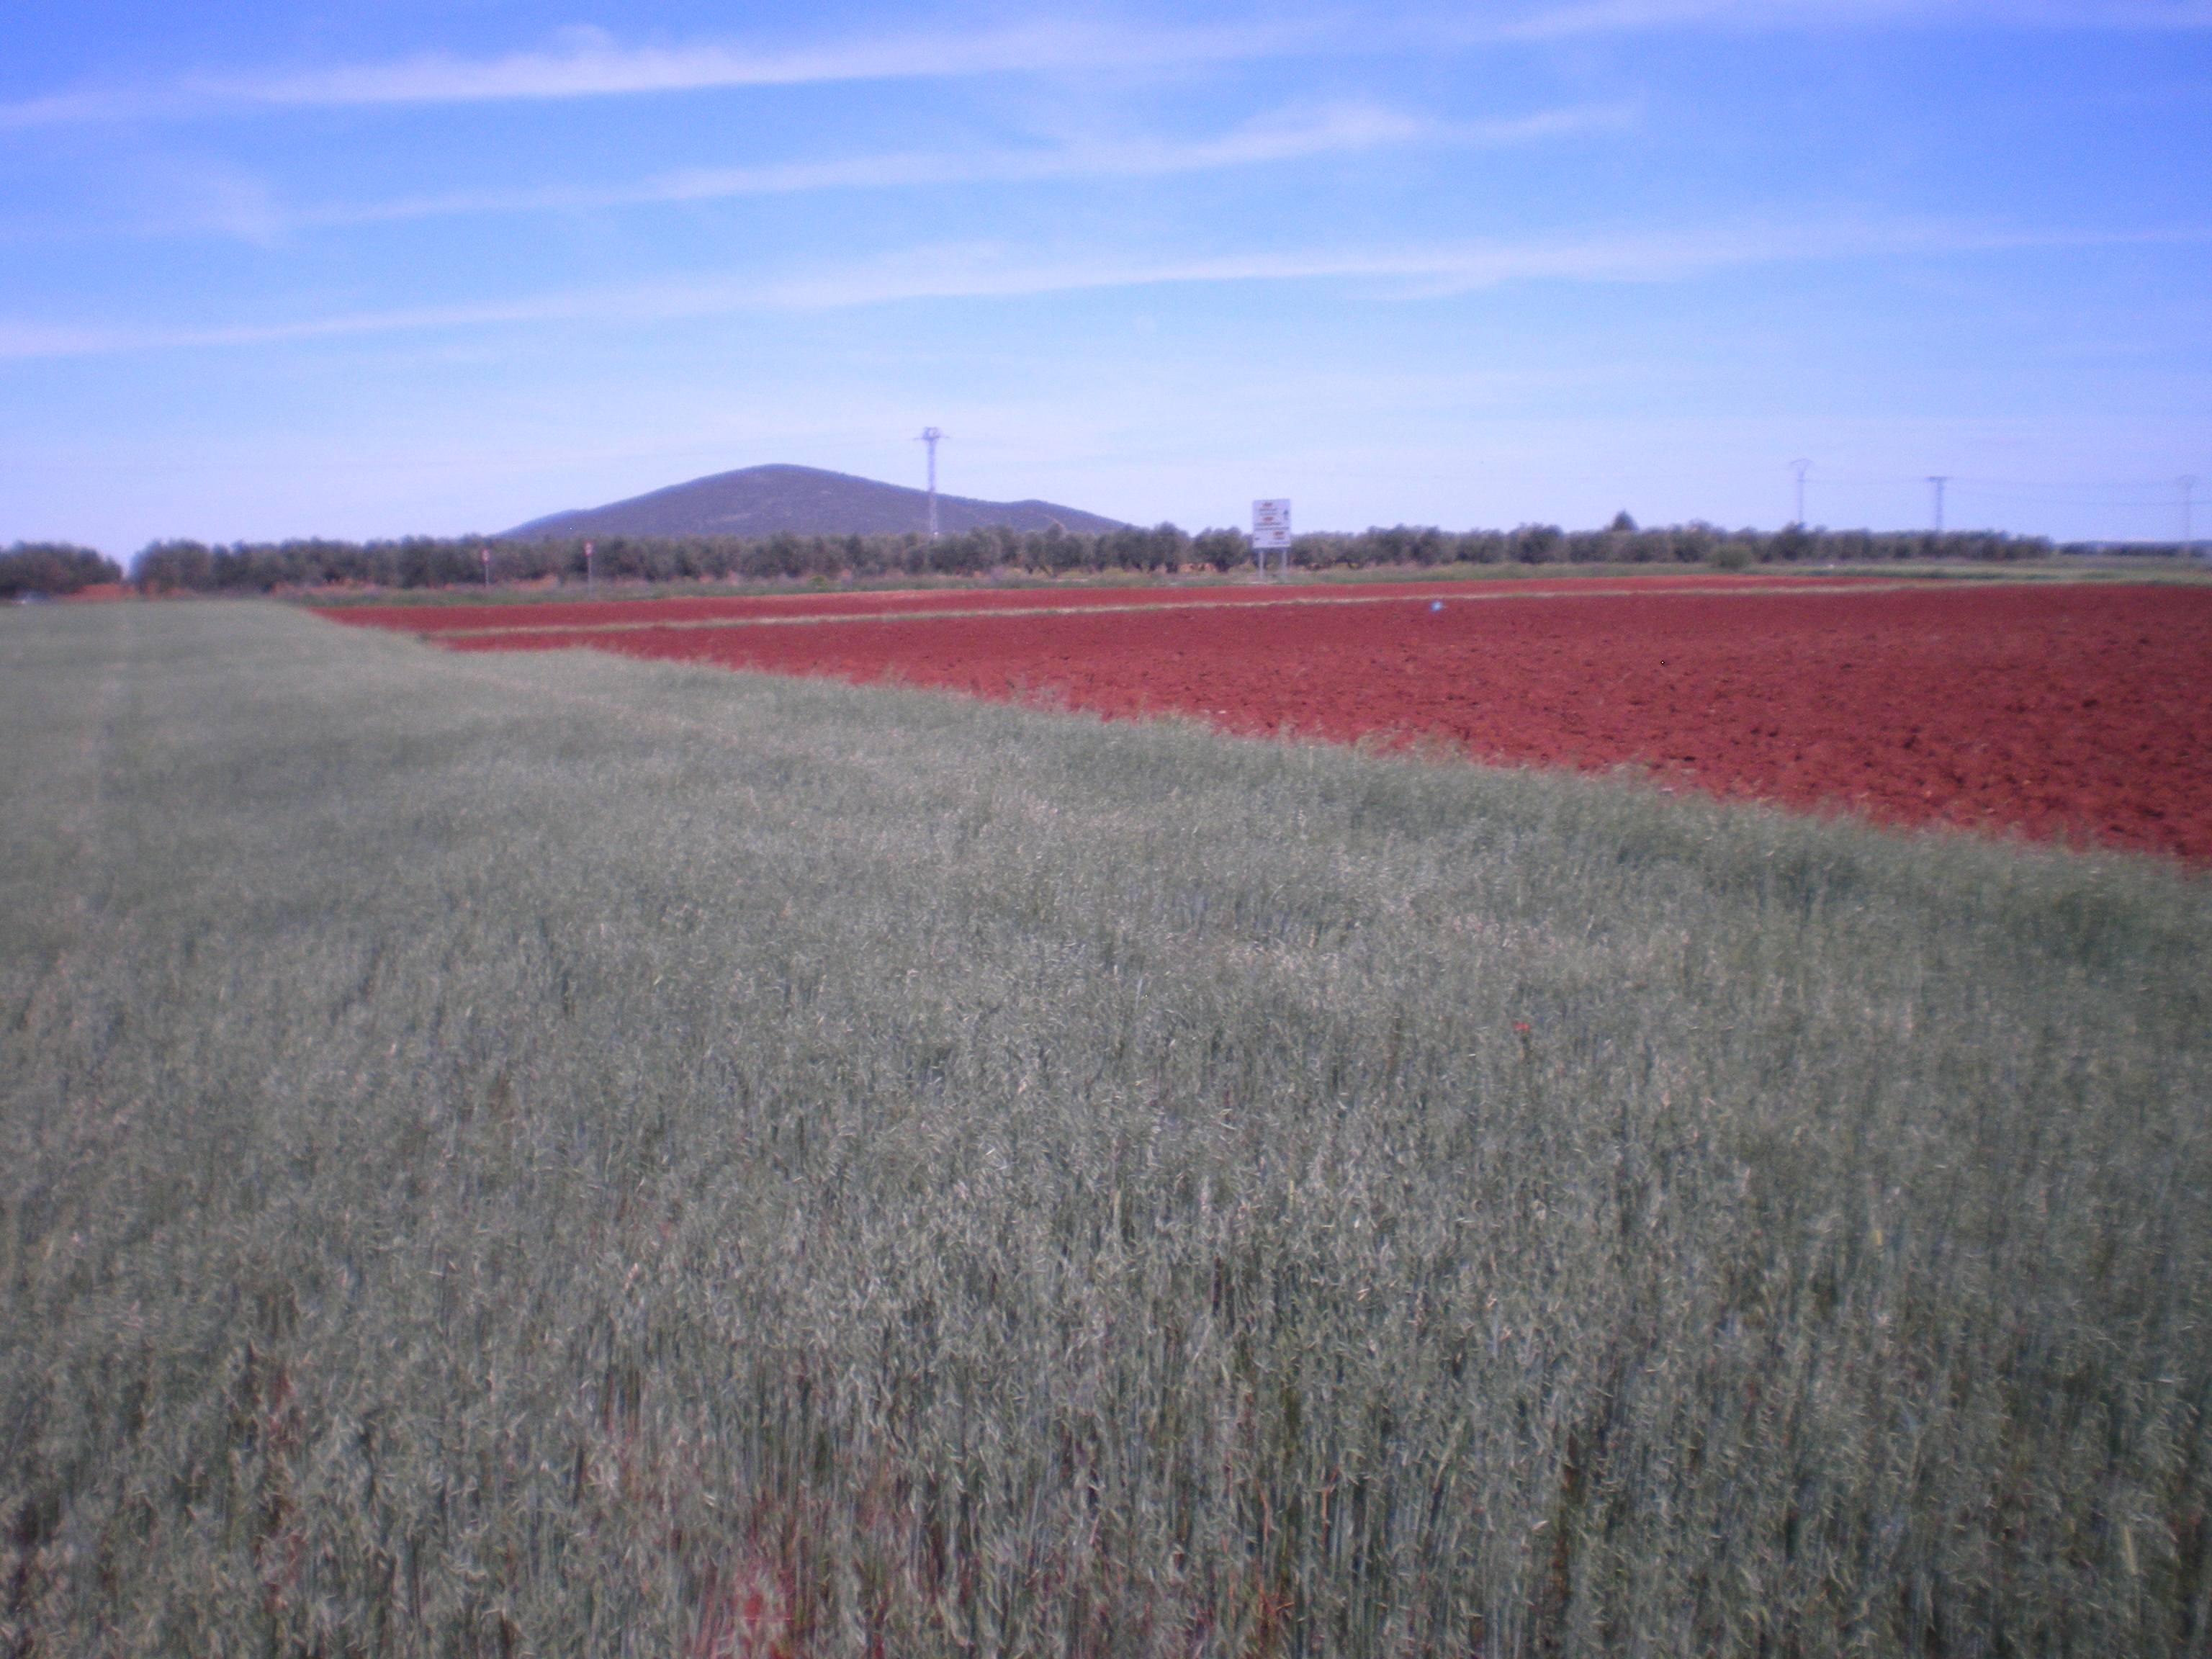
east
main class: Cropland
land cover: Oats
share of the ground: > 75 %
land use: Agriculture (excluding fallow land and kitchen gardens)
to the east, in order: Oats; Grass margins; Other bare soil; Grass margins; Tracks; Grass margins; Other bare soil; Grass margins; Paved roads, cycling and walking lanes; Grass margins; Olive groves; Grass margins; Tracks; Grass margins; Olive groves; Tracks; Olive groves
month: April
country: ES
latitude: 38.6186
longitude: -3.3429
